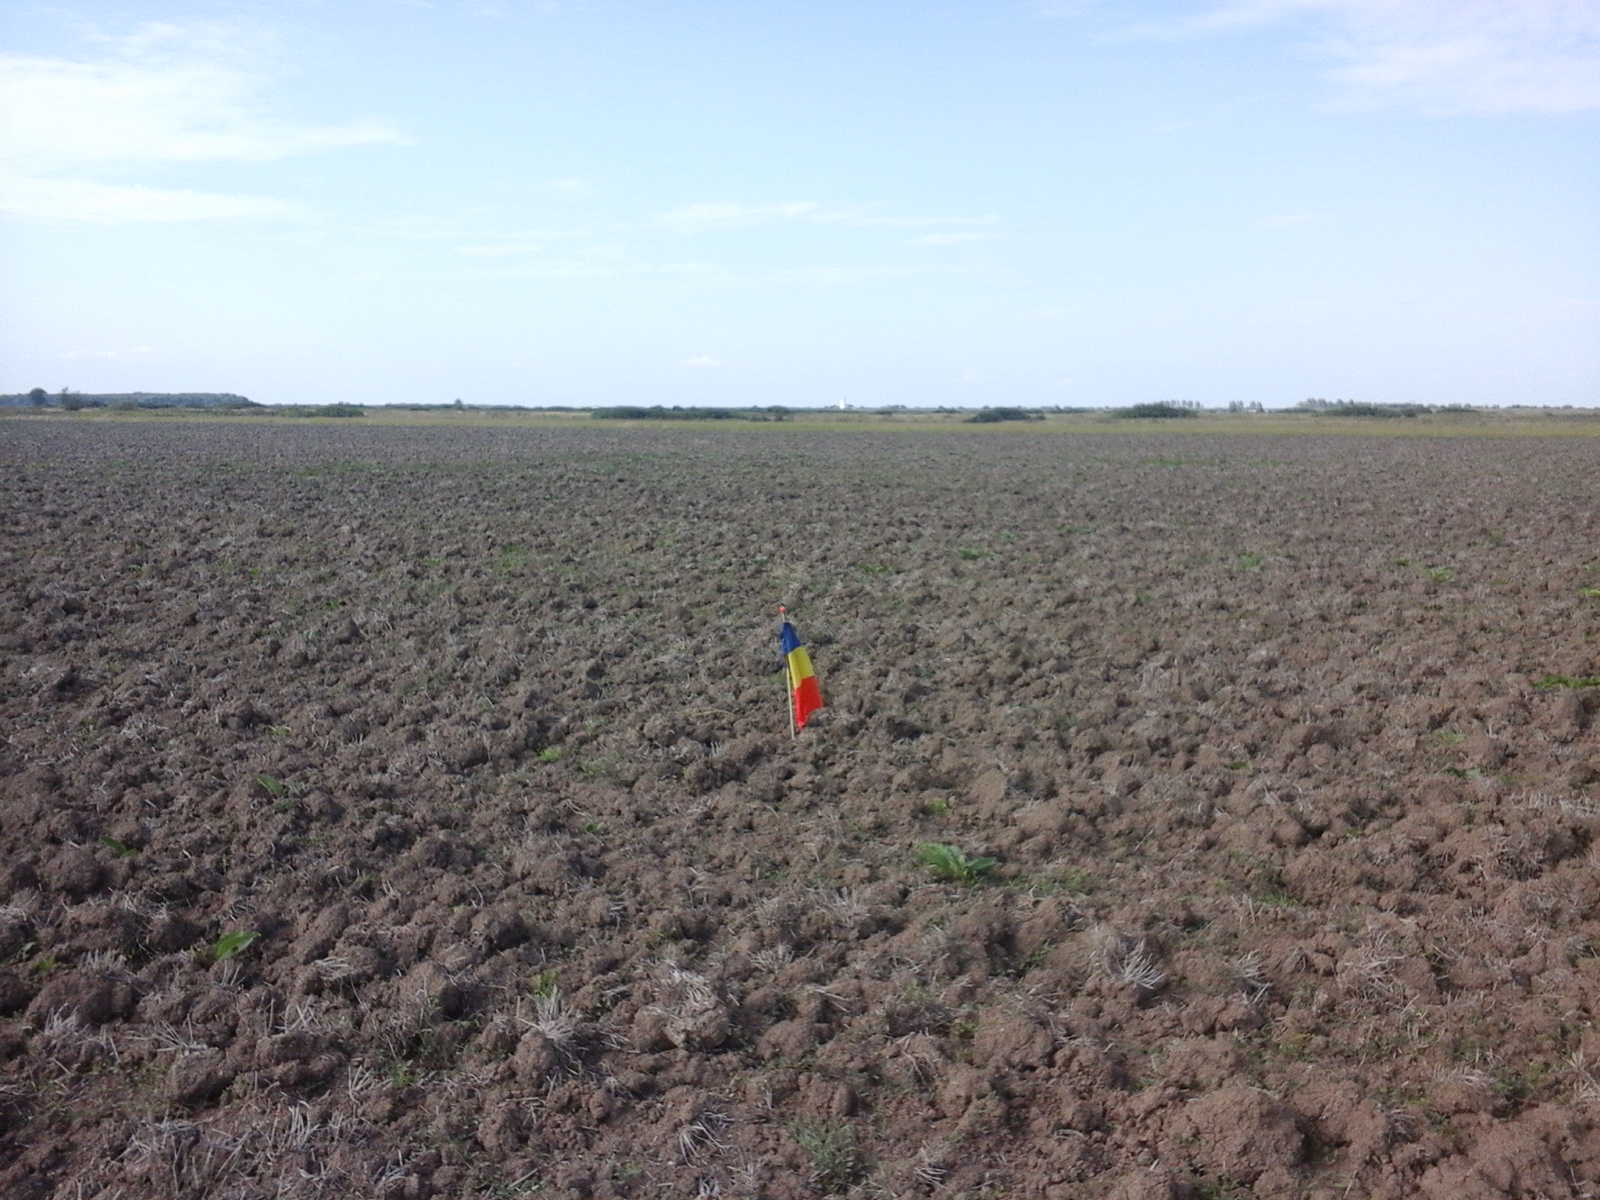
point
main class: Cropland
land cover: Common wheat
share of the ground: < 10 %
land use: Agriculture (excluding fallow land and kitchen gardens)
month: August
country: RO
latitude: 46.6412
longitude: 21.4692
